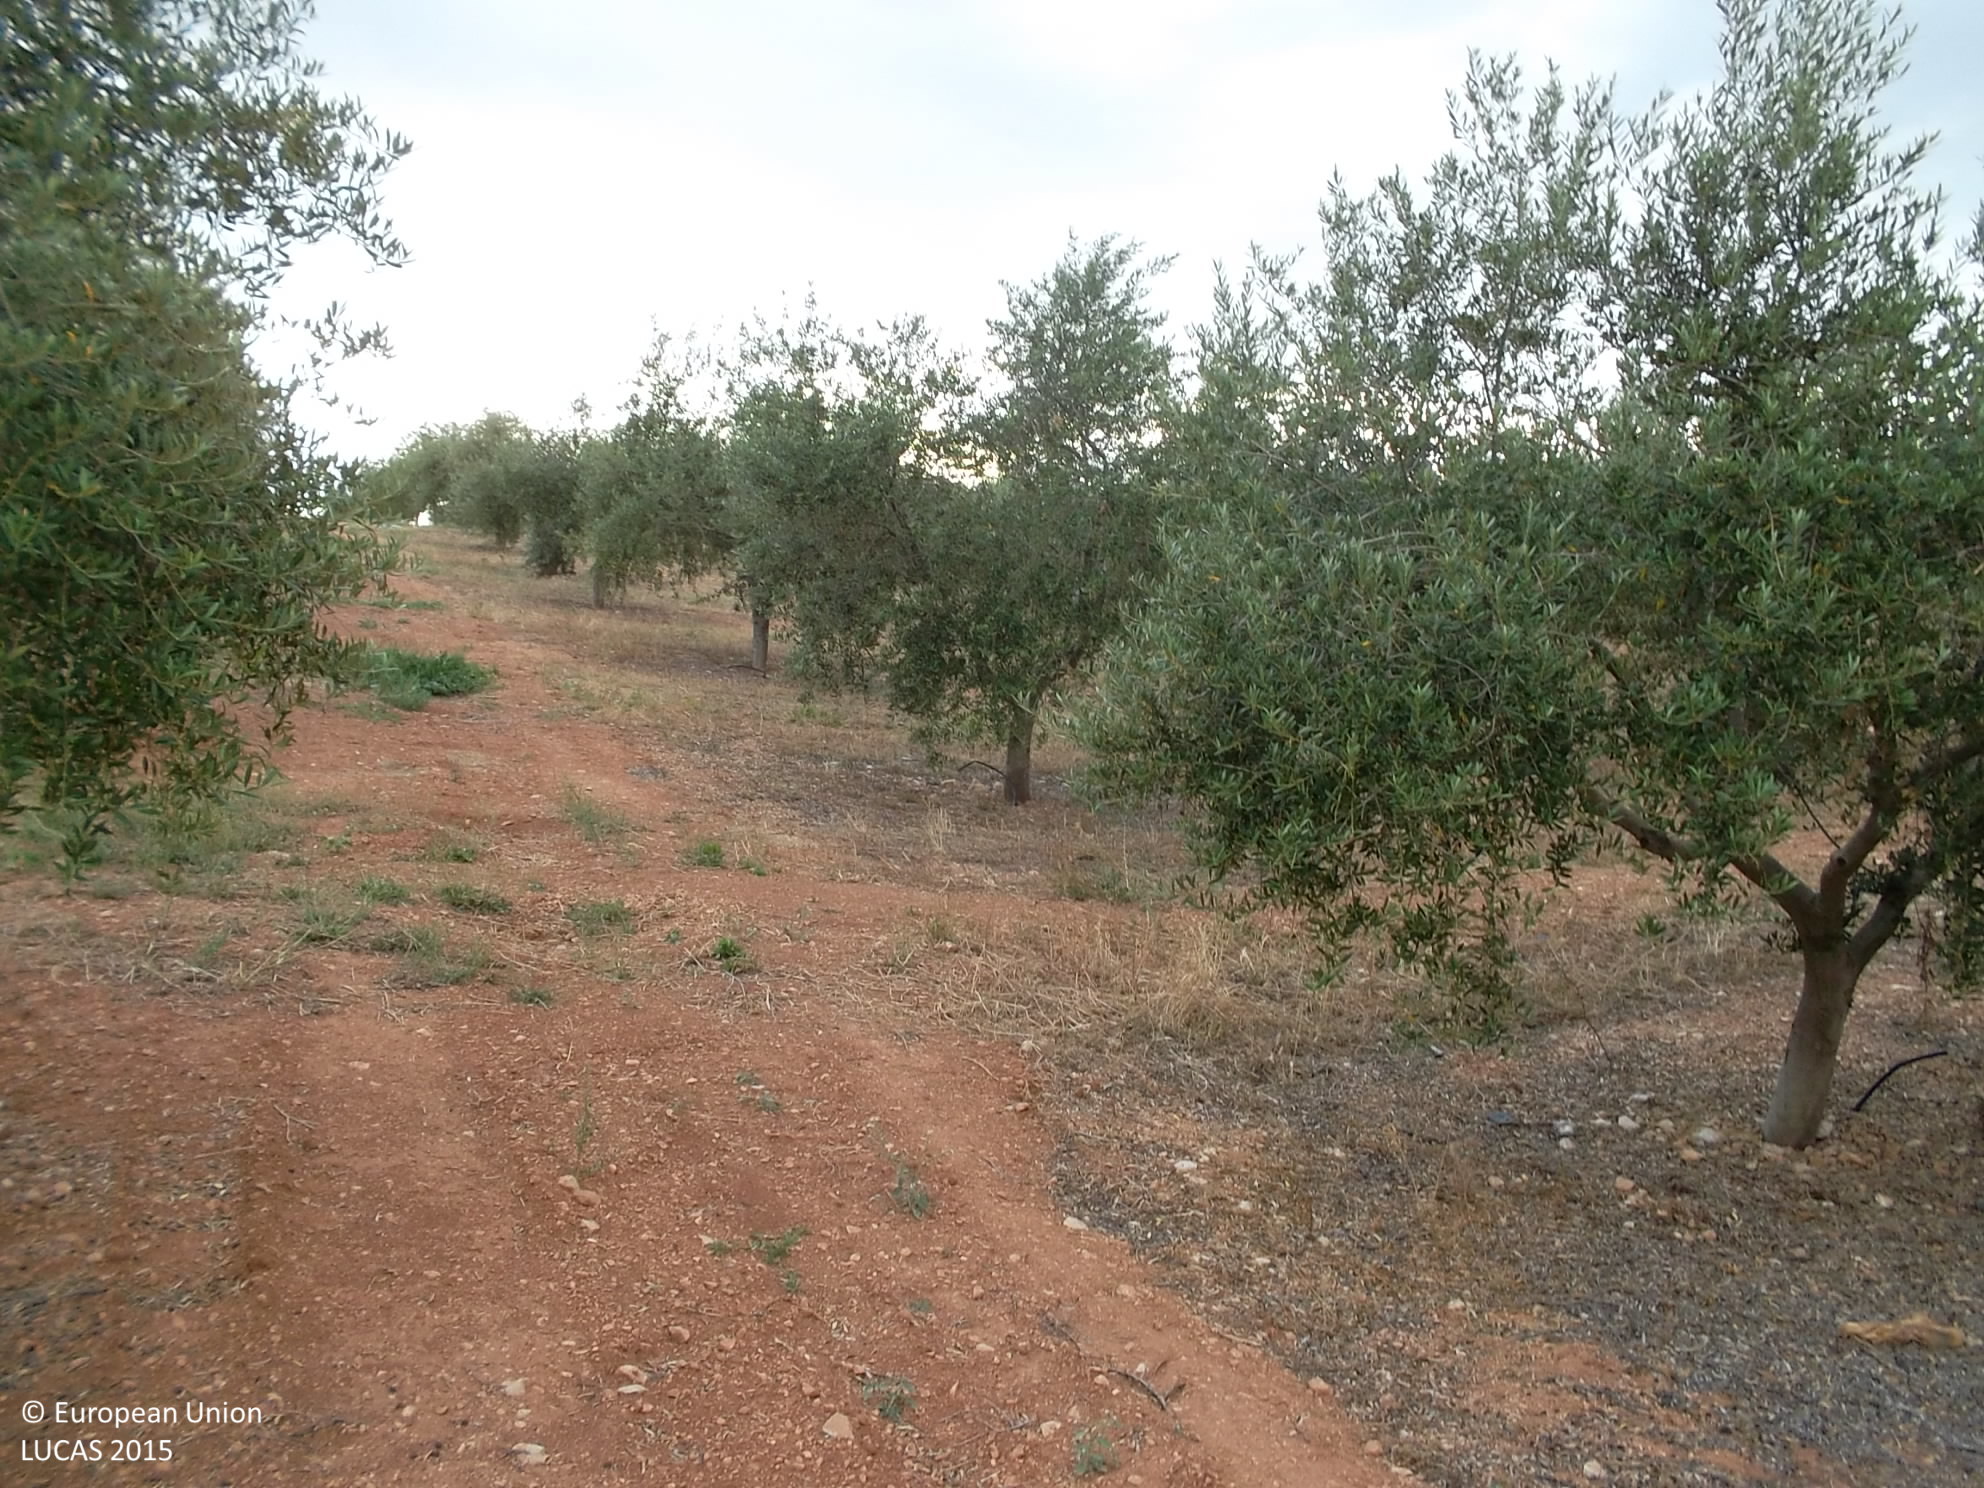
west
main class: Cropland
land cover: Olive groves
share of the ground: 25 - 50 %
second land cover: Other bare soil
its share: > 75 %
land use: Agriculture (excluding fallow land and kitchen gardens)
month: June
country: ES
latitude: 37.5945
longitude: -3.3238
